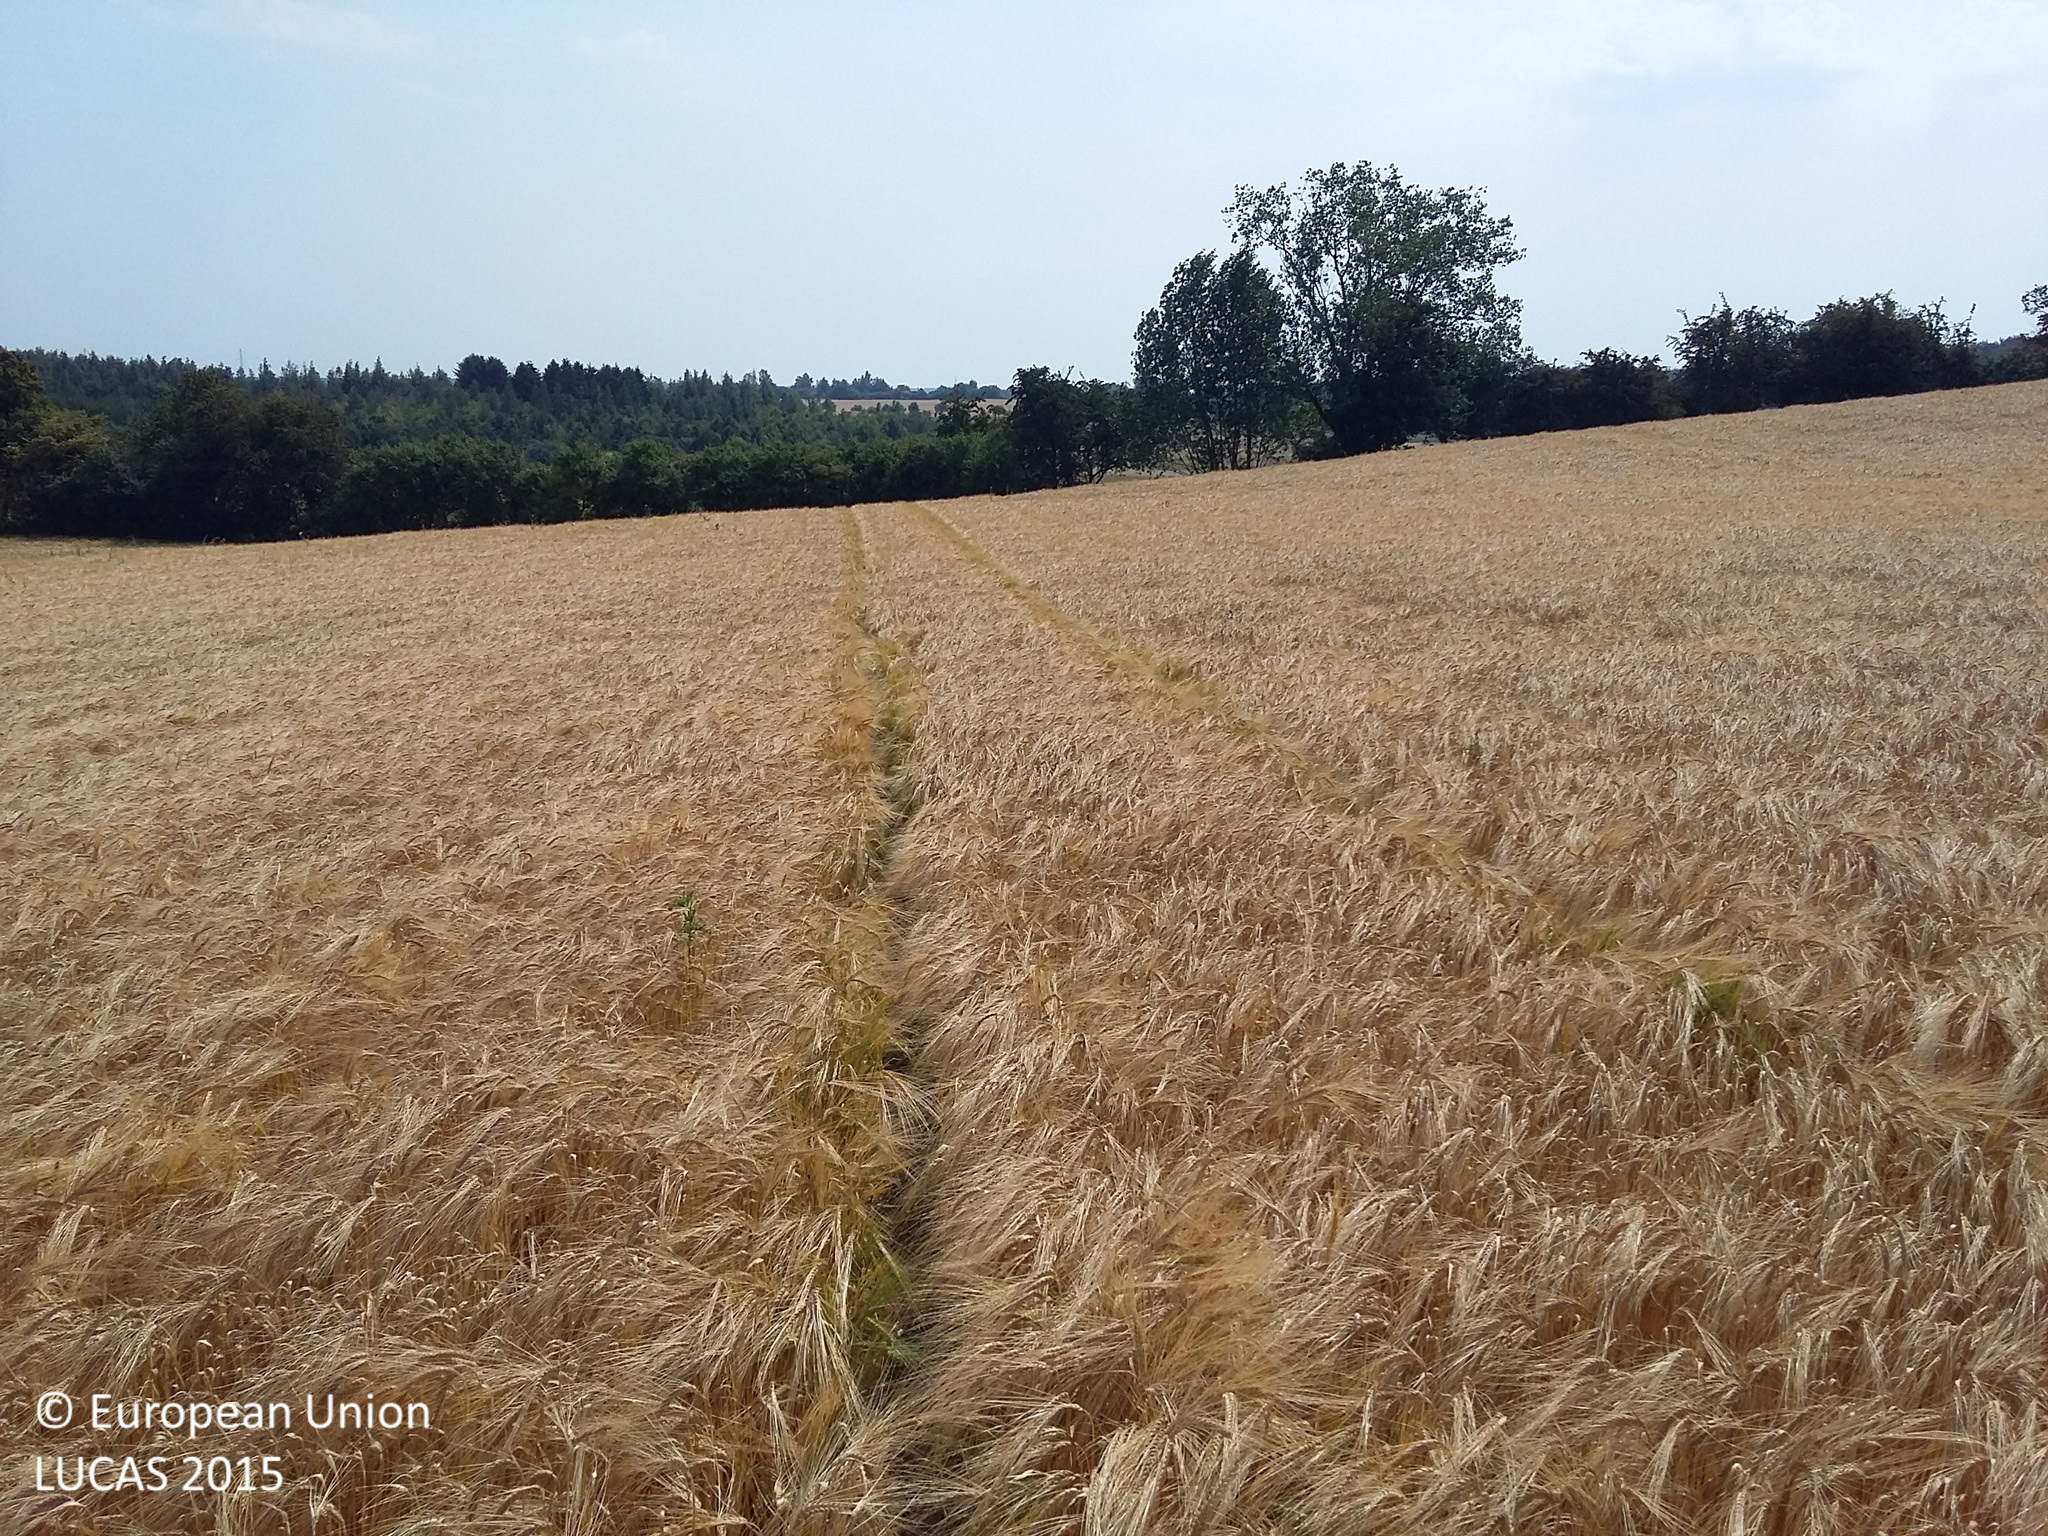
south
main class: Cropland
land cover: Barley
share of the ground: > 75 %
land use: Agriculture (excluding fallow land and kitchen gardens)
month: August
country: DK
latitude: 55.5057
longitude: 12.0724
